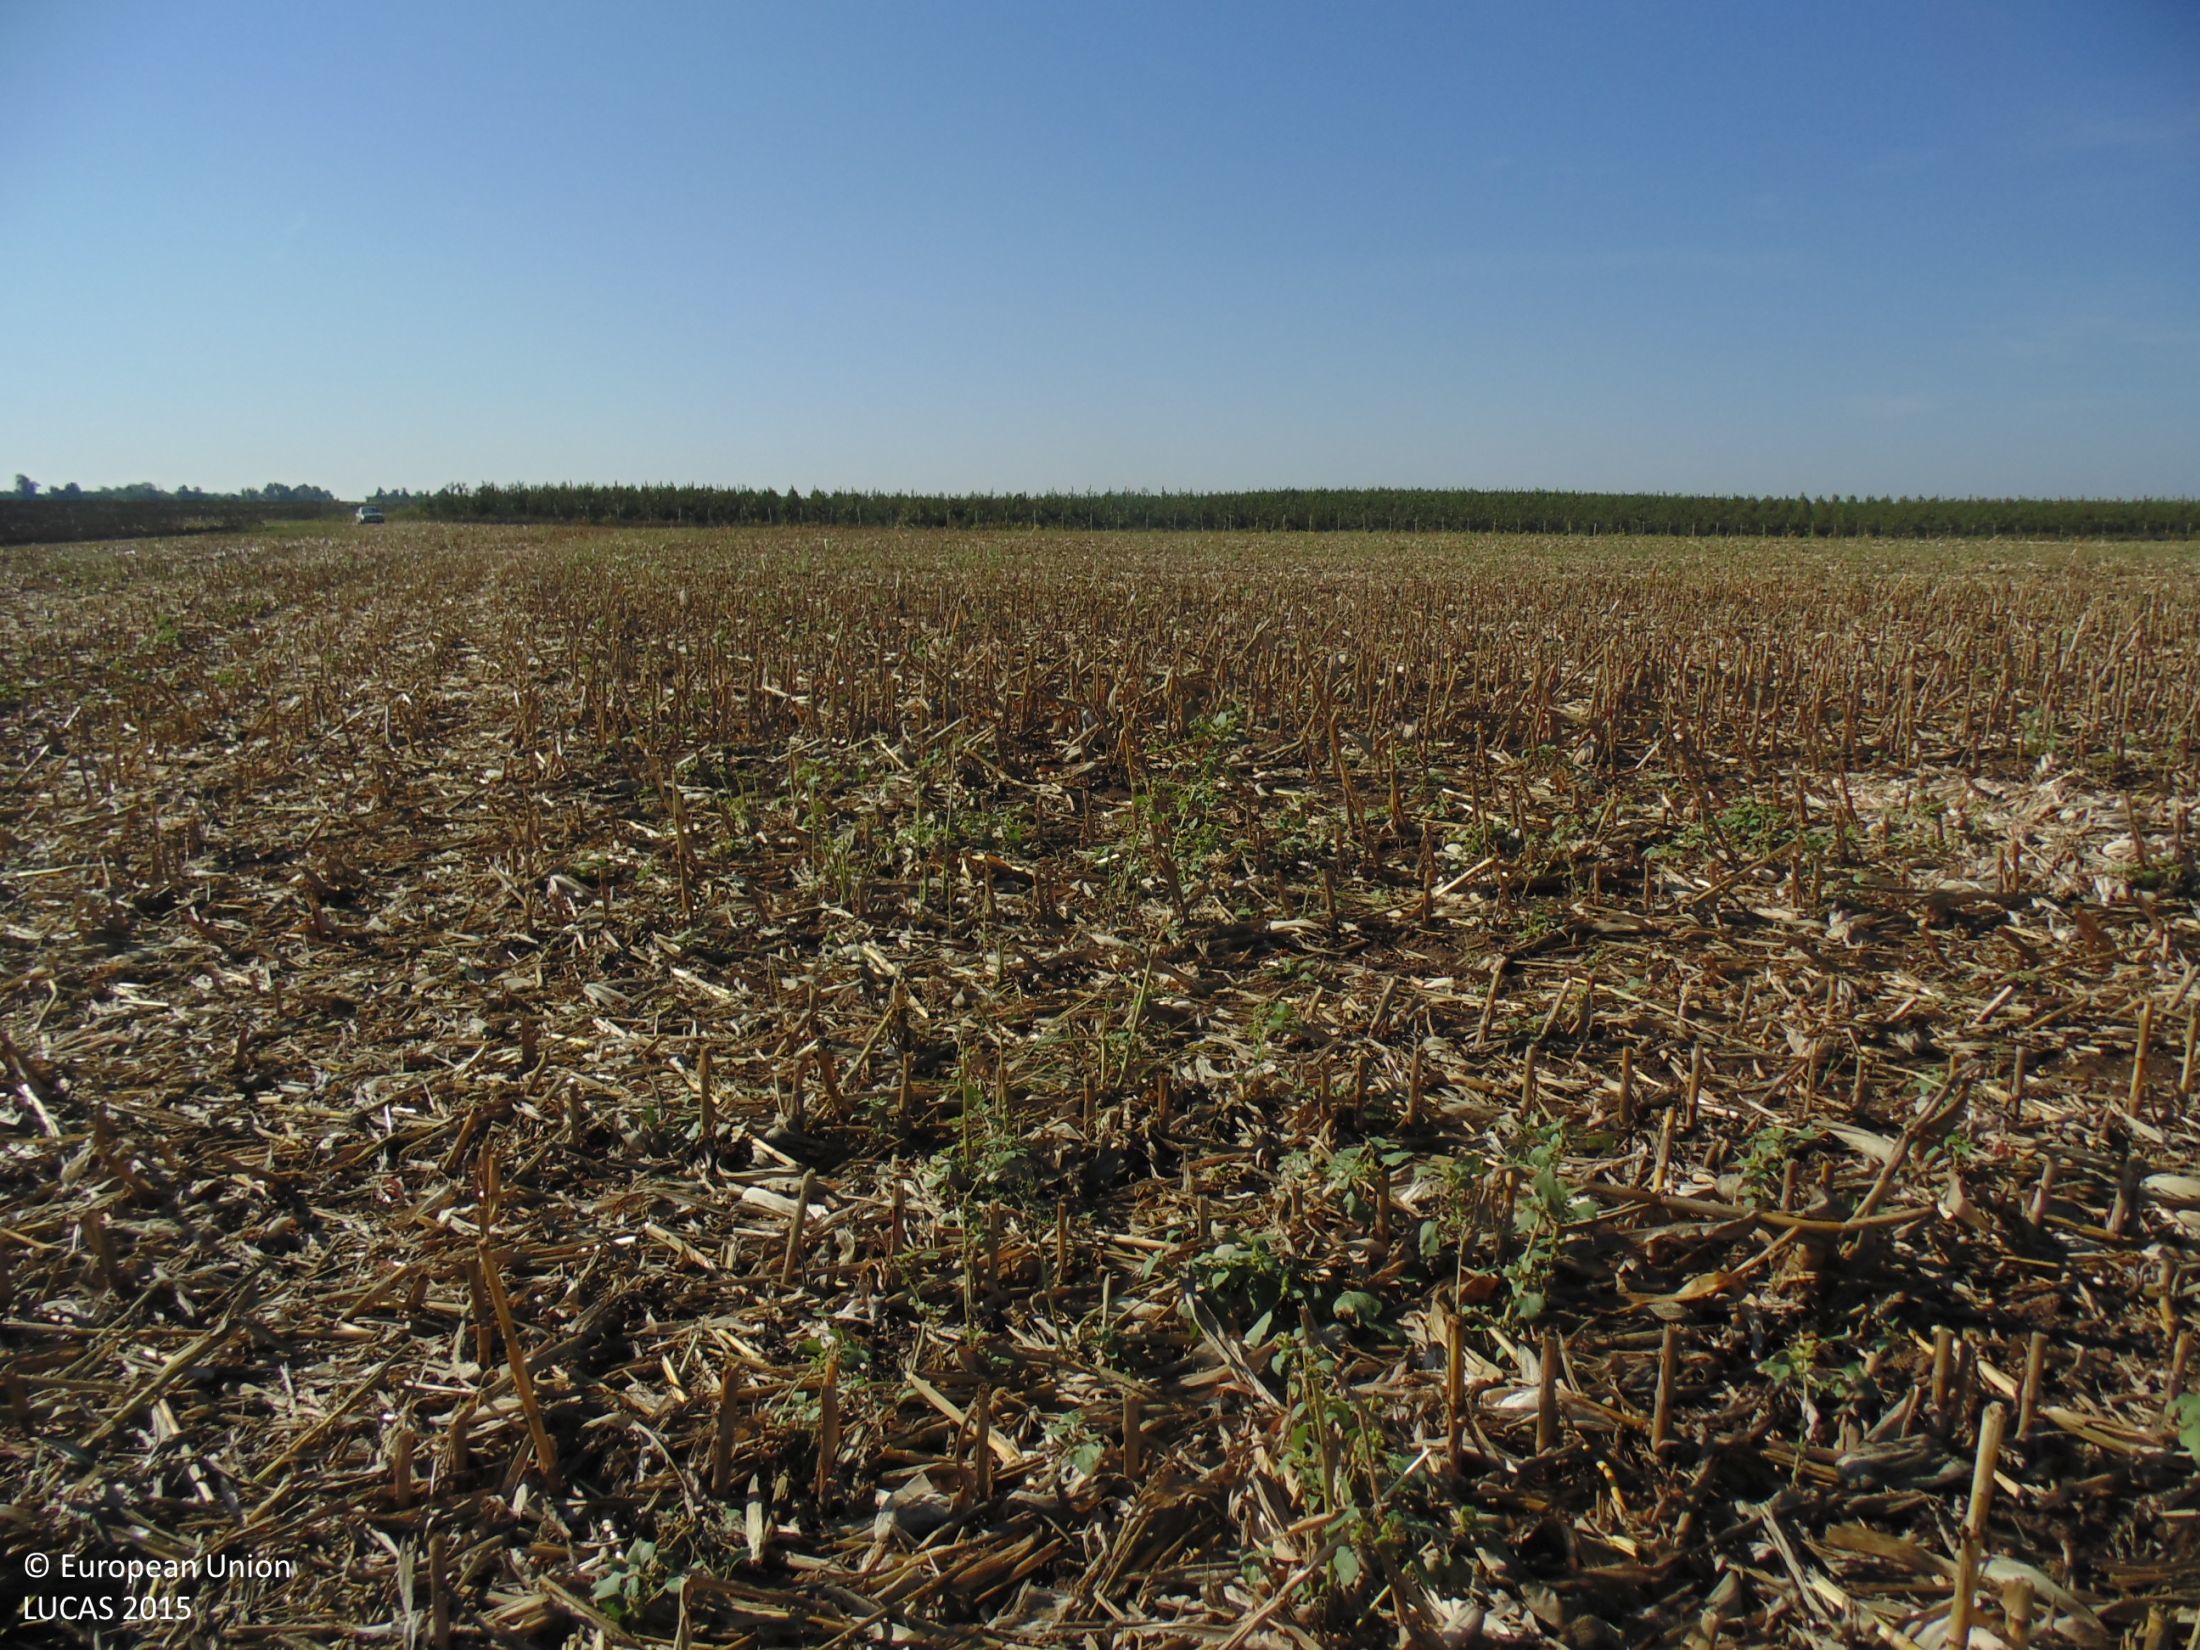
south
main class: Cropland
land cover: Maize
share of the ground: 10 - 25 %
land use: Agriculture (excluding fallow land and kitchen gardens)
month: September
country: BG
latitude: 44.1080
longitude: 27.0291
